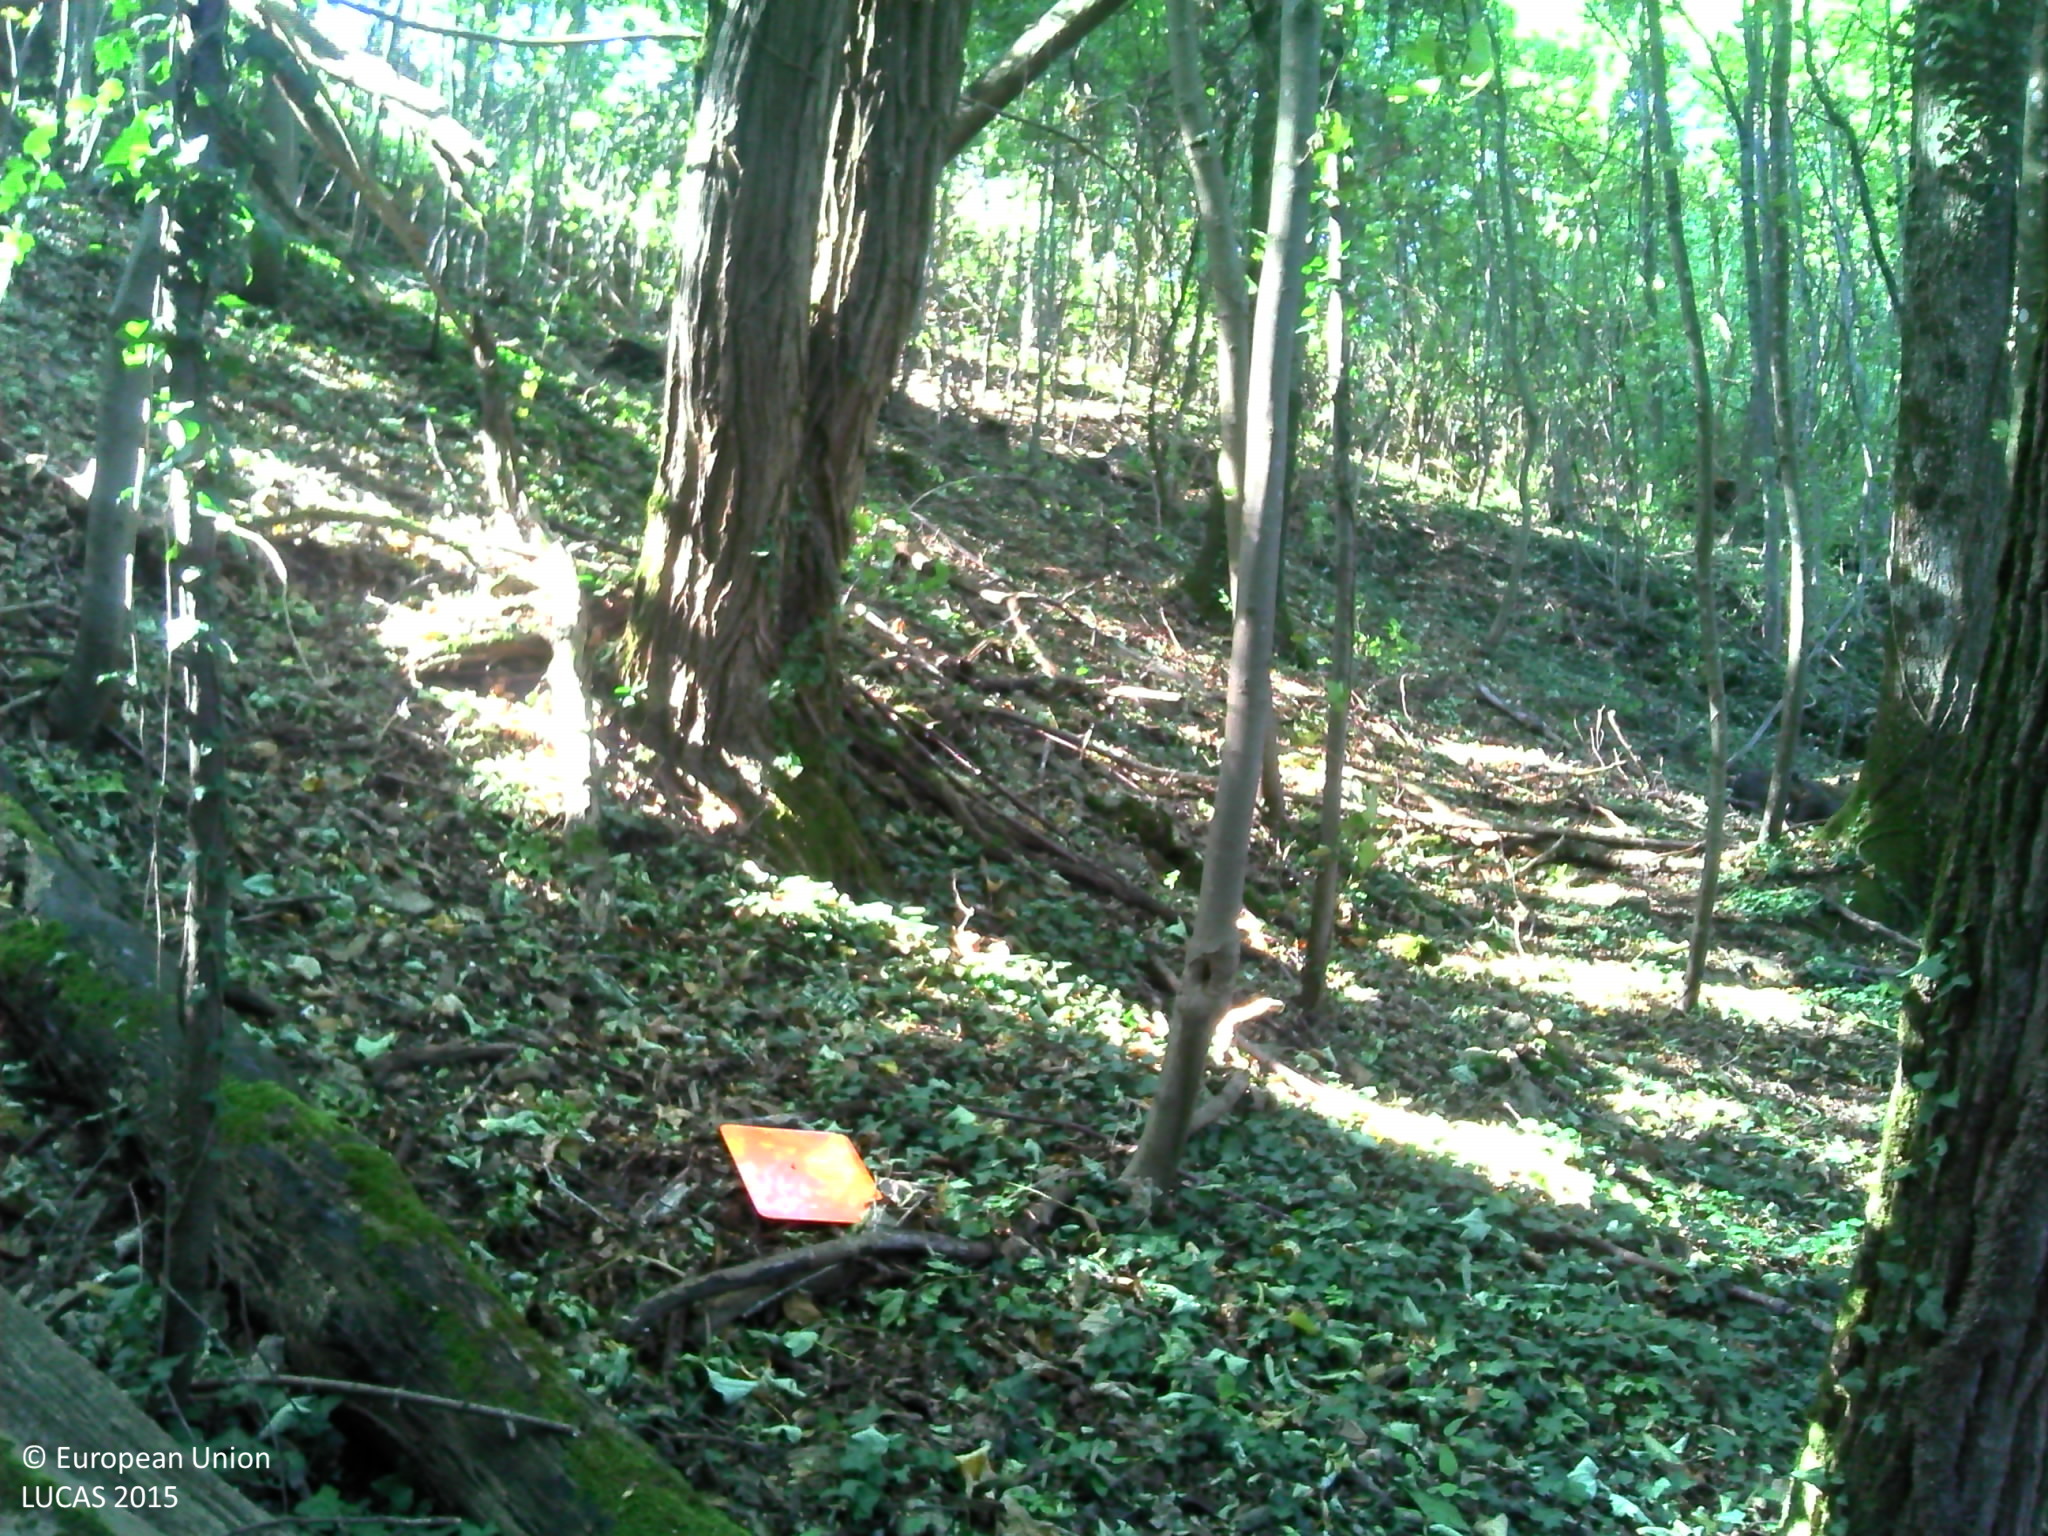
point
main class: Woodland
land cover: Broadleaved woodland
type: mesophytic deciduous forest
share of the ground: > 75 %
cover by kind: broadleaved forest trees 90 %, herbaceous plants 5 %, consolidated bare surface 5 %
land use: Forestry
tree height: > 5 m
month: October
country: FR
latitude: 48.9086
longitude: 6.0293
